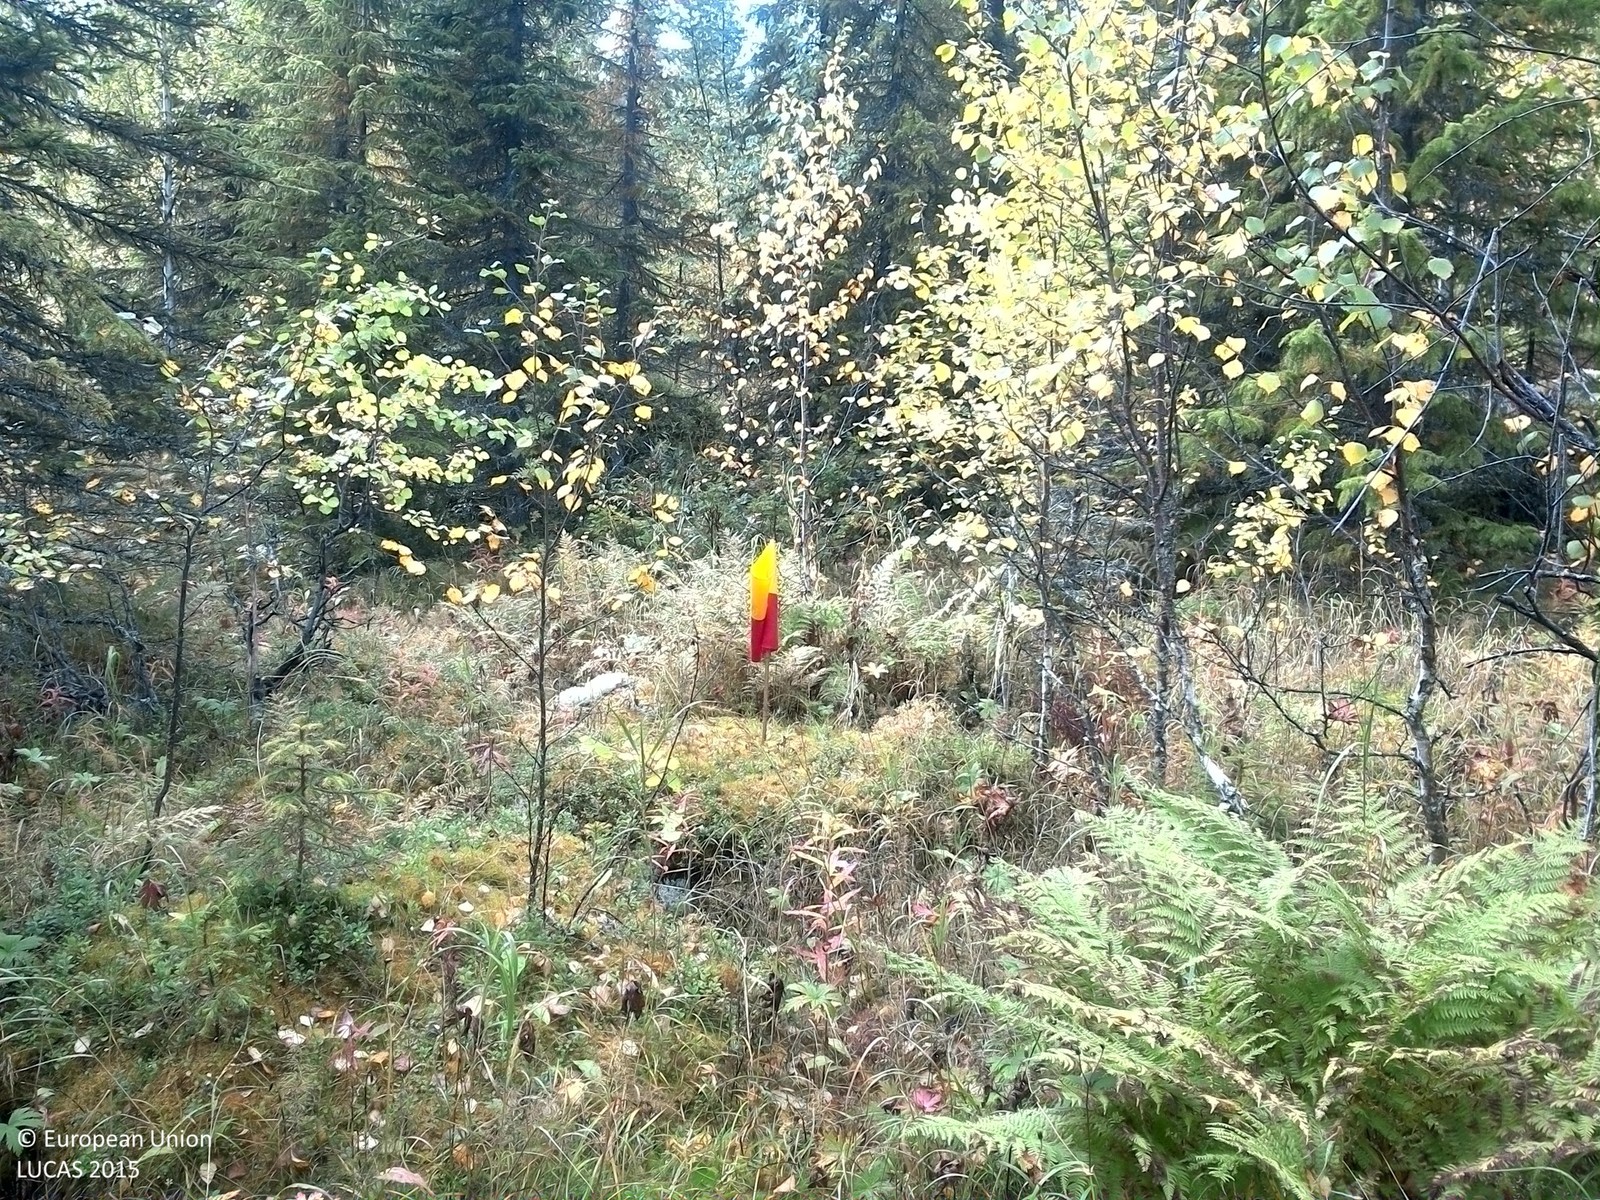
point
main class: Woodland
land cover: Spruce dominated mixed woodland
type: boreal forest
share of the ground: > 75 %
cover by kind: coniferous forest trees 55 %, broadleaved forest trees 20 %, herbaceous plants 15 %, shrubs 5 %, lichens and mosses 5 %
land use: Forestry
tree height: > 5 m
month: September
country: SE
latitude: 63.5817
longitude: 15.9169
